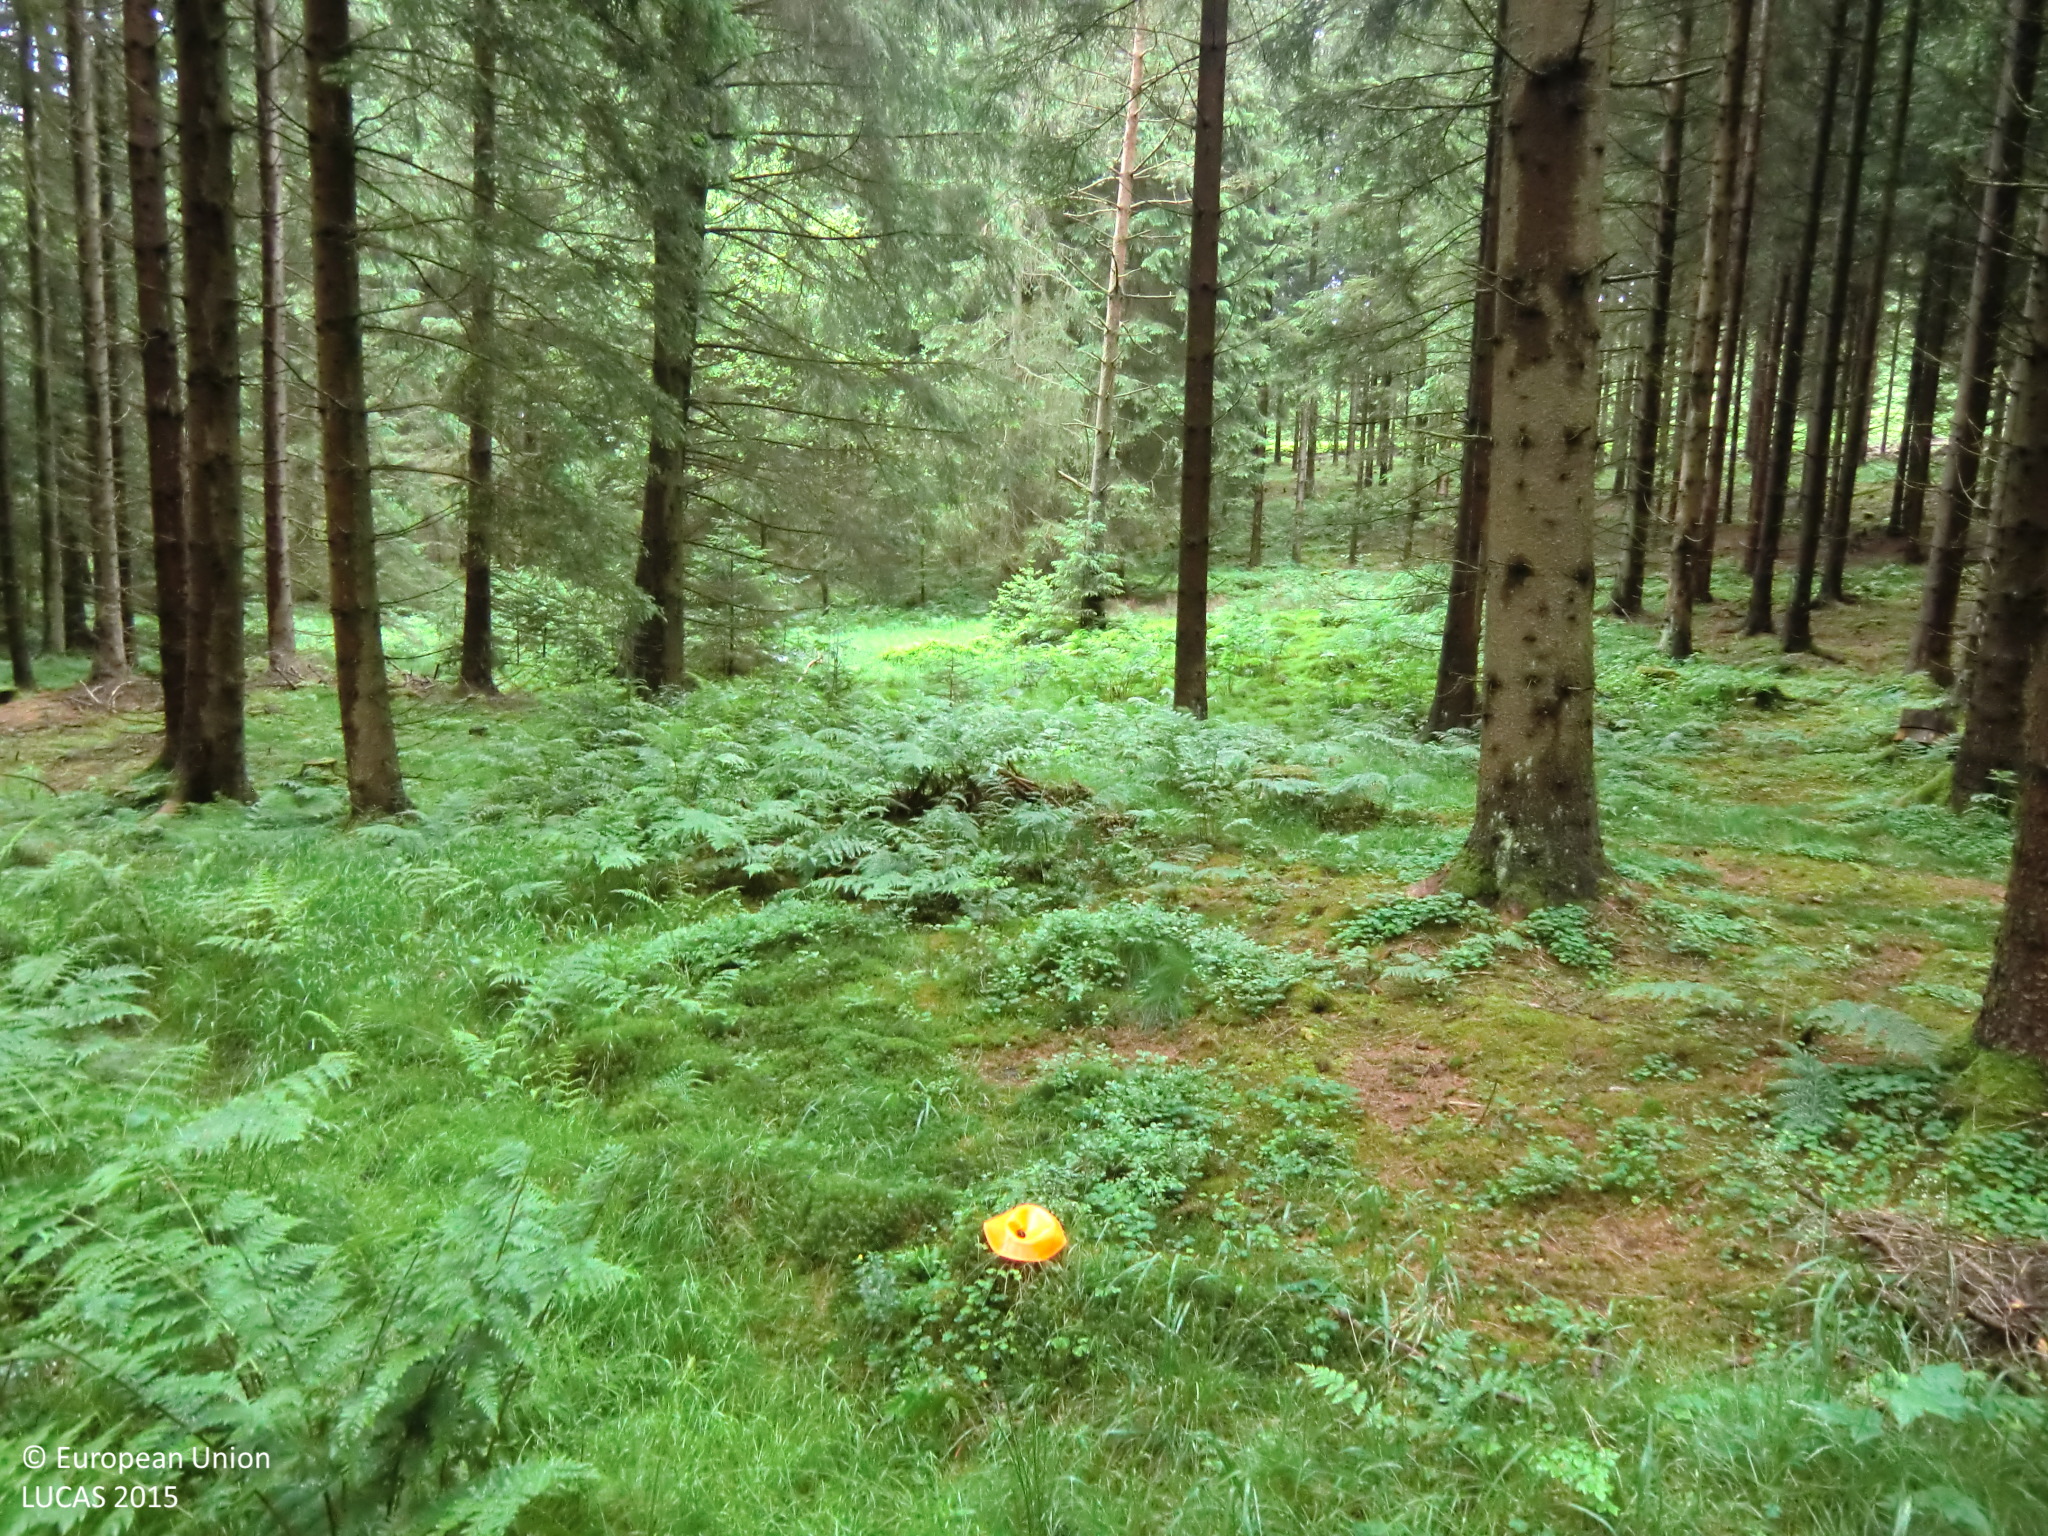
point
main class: Woodland
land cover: Spruce dominated coniferous woodland
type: hemiboreal forest and nemoral coniferous forest and mixed broadleaved-coniferous forest
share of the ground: > 75 %
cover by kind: coniferous forest trees 75 %, herbaceous plants 15 %, lichens and mosses 10 %
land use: Forestry
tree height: > 5 m
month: June
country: AT
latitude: 48.4661
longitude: 14.6940
